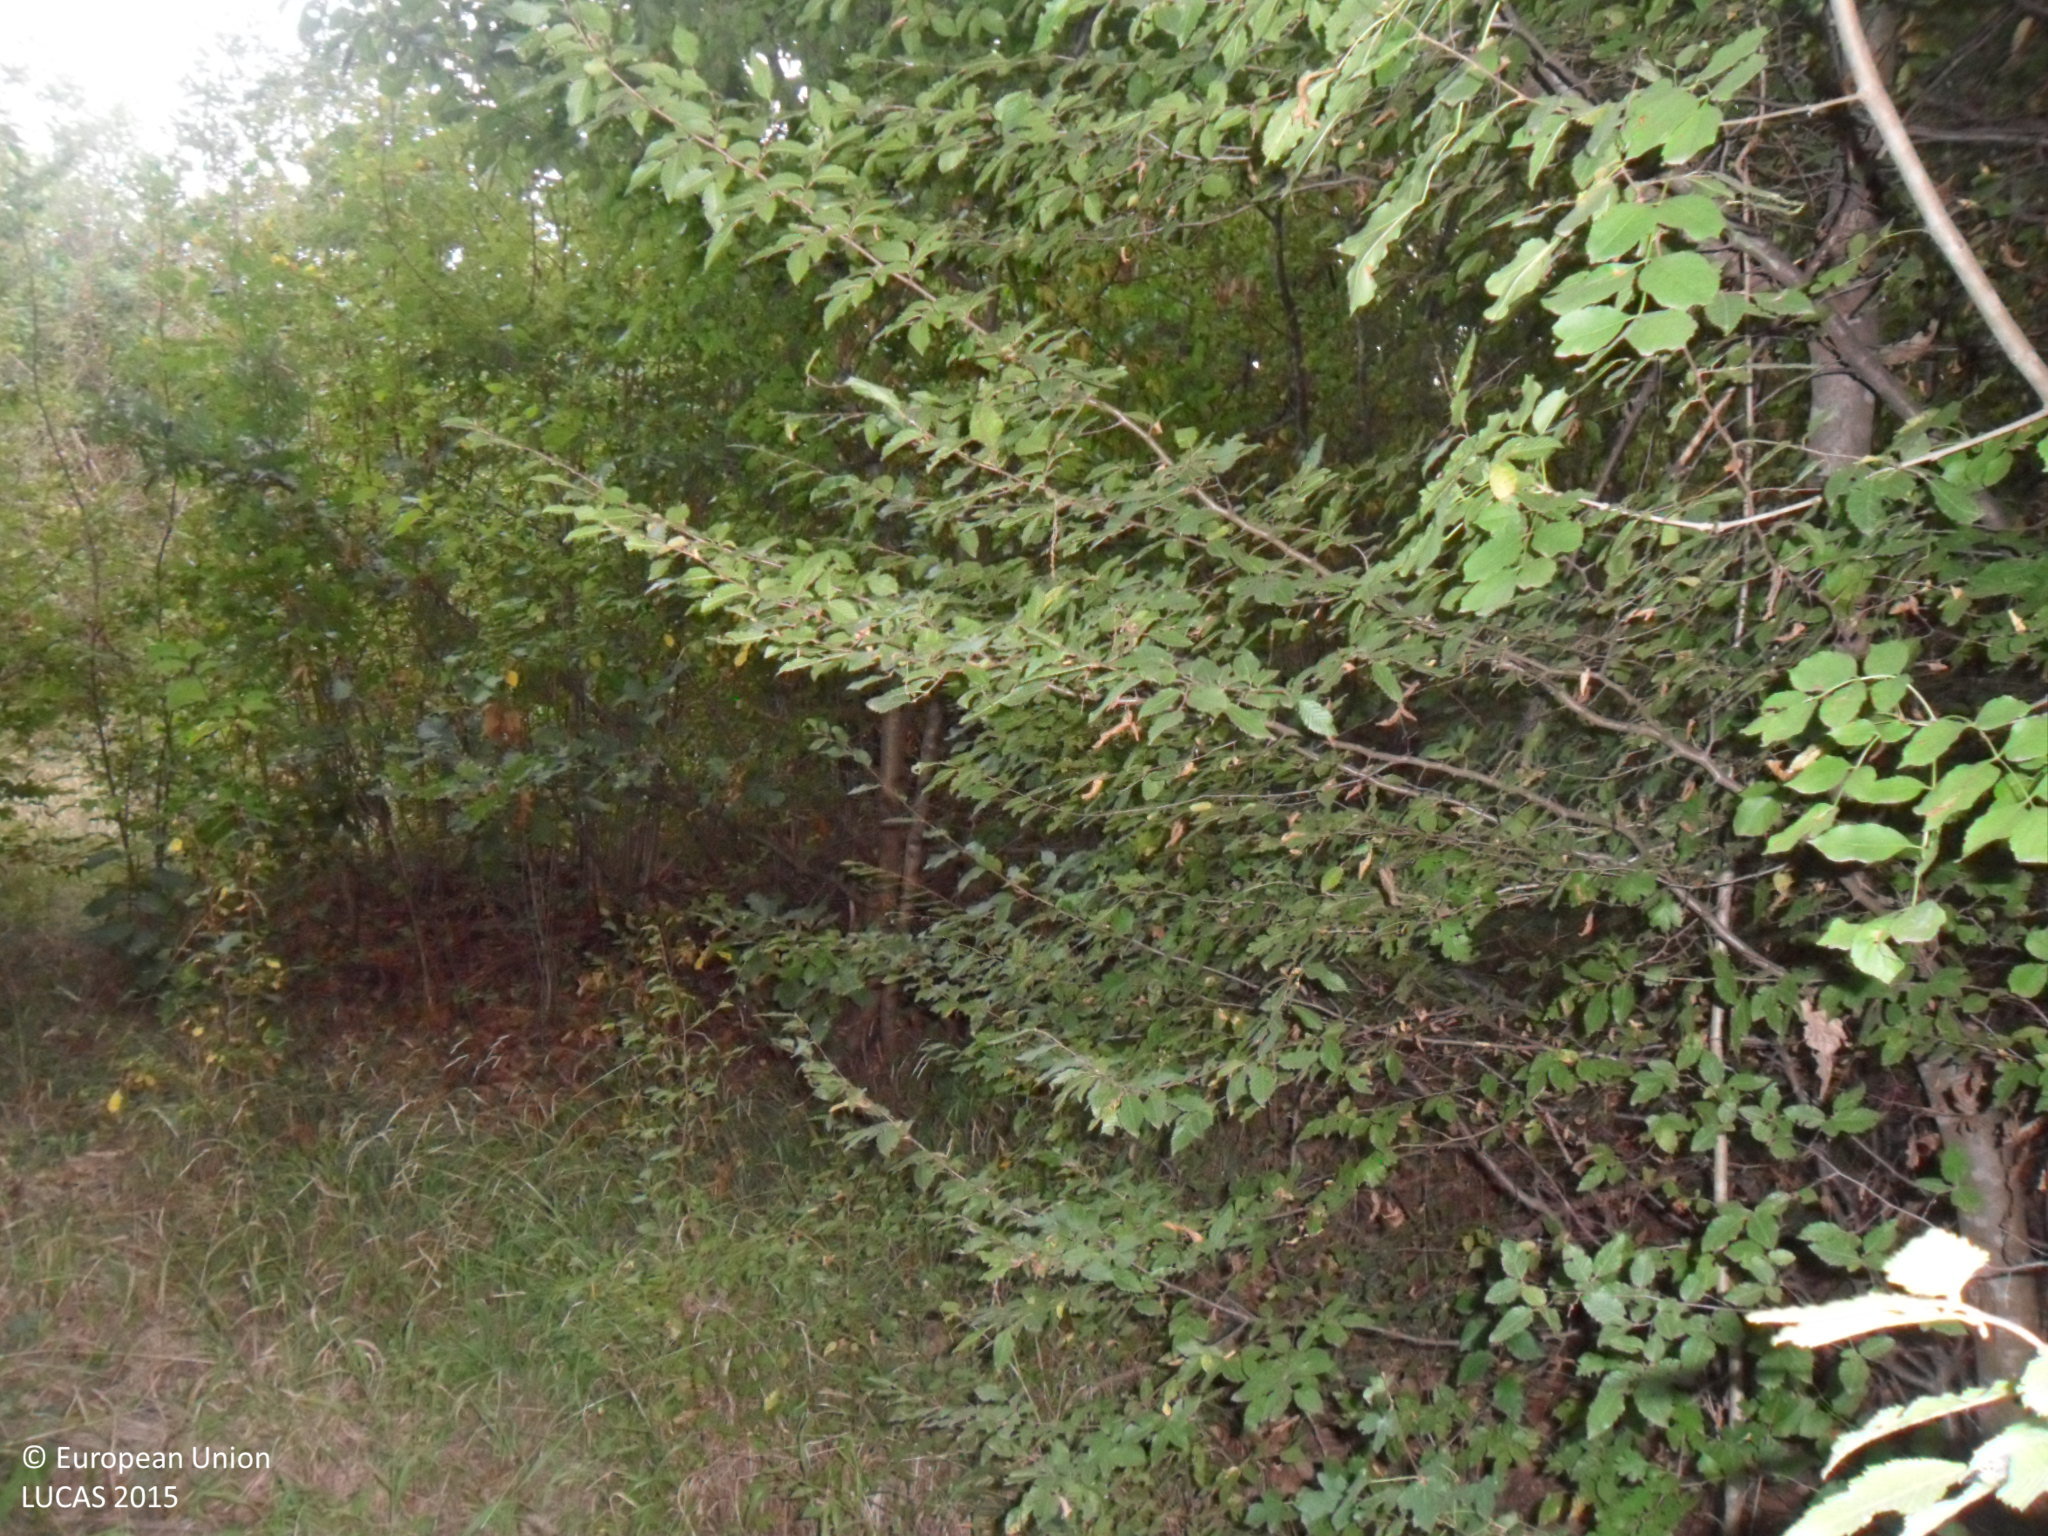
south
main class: Woodland
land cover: Broadleaved woodland
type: mesophytic deciduous forest
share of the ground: > 75 %
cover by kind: broadleaved forest trees 100 %
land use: Forestry
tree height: > 5 m
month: September
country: BG
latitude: 43.6504
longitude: 26.2300
